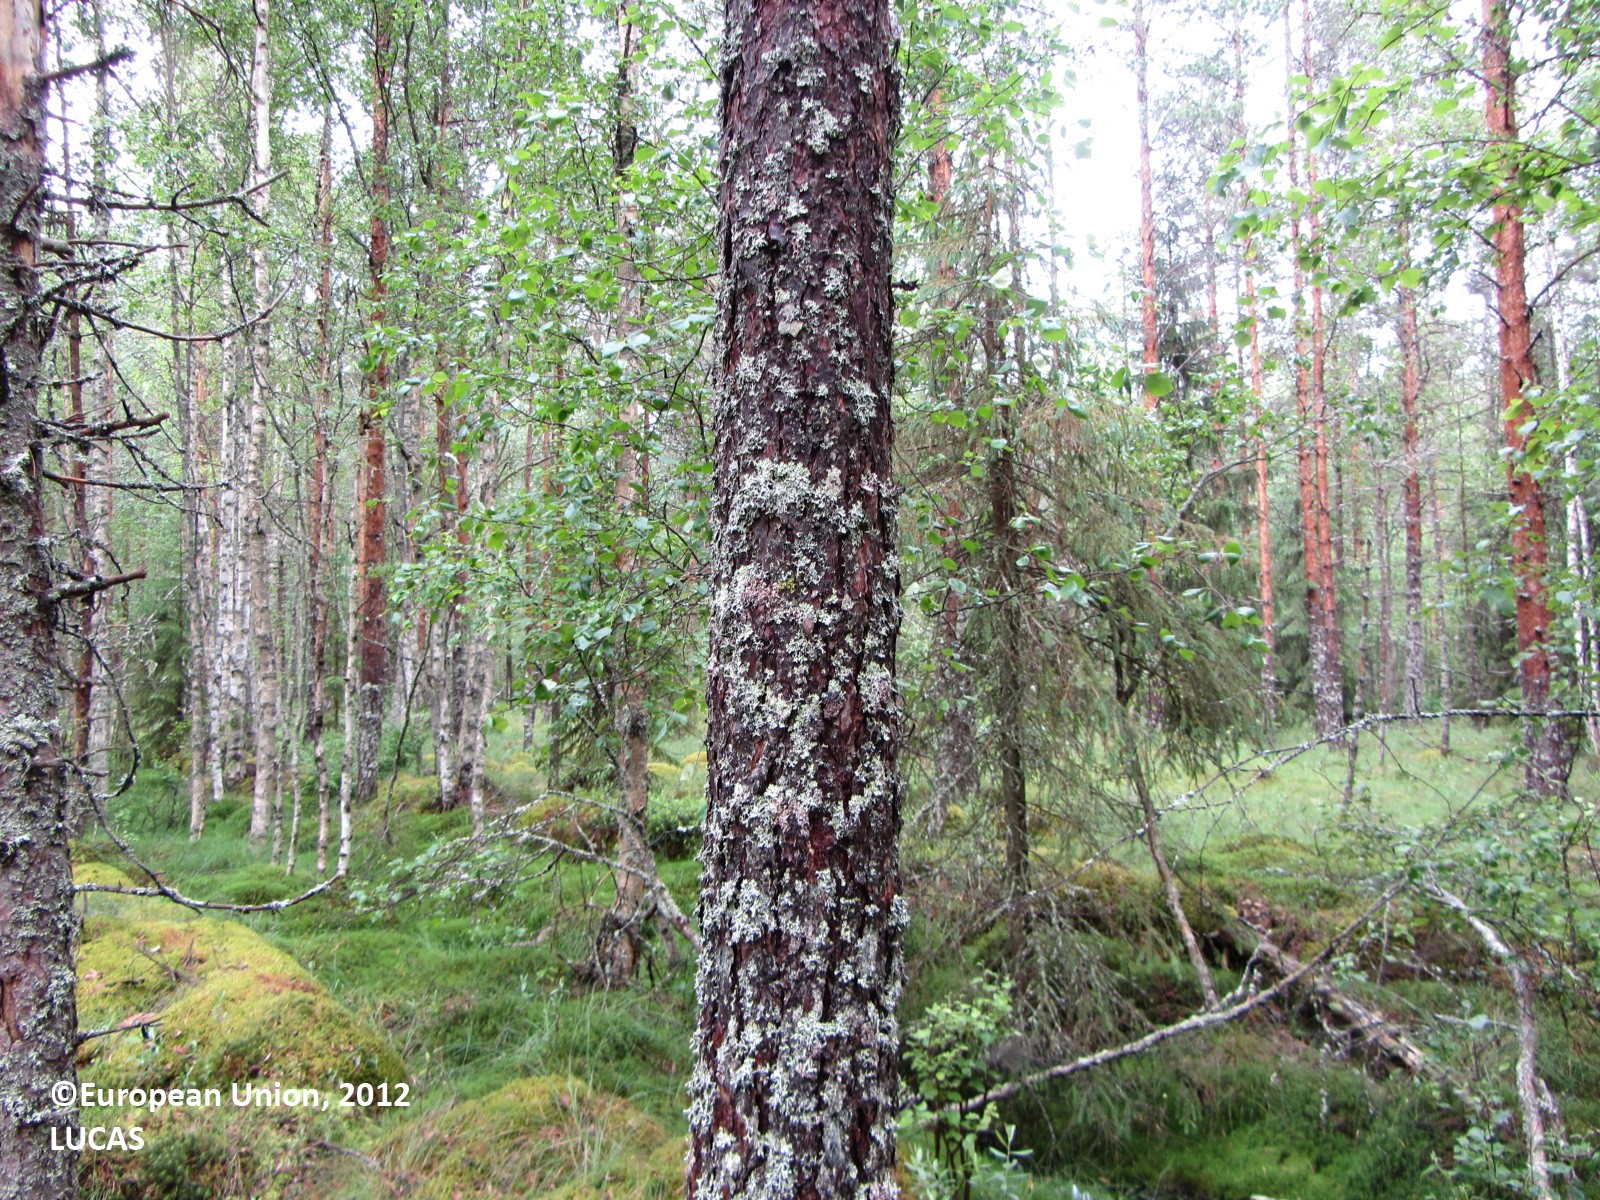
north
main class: Woodland
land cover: Pine dominated mixed woodland
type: boreal forest
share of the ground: > 75 %
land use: Forestry
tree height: > 5 m
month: July
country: FI
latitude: 63.8967
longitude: 25.6015
